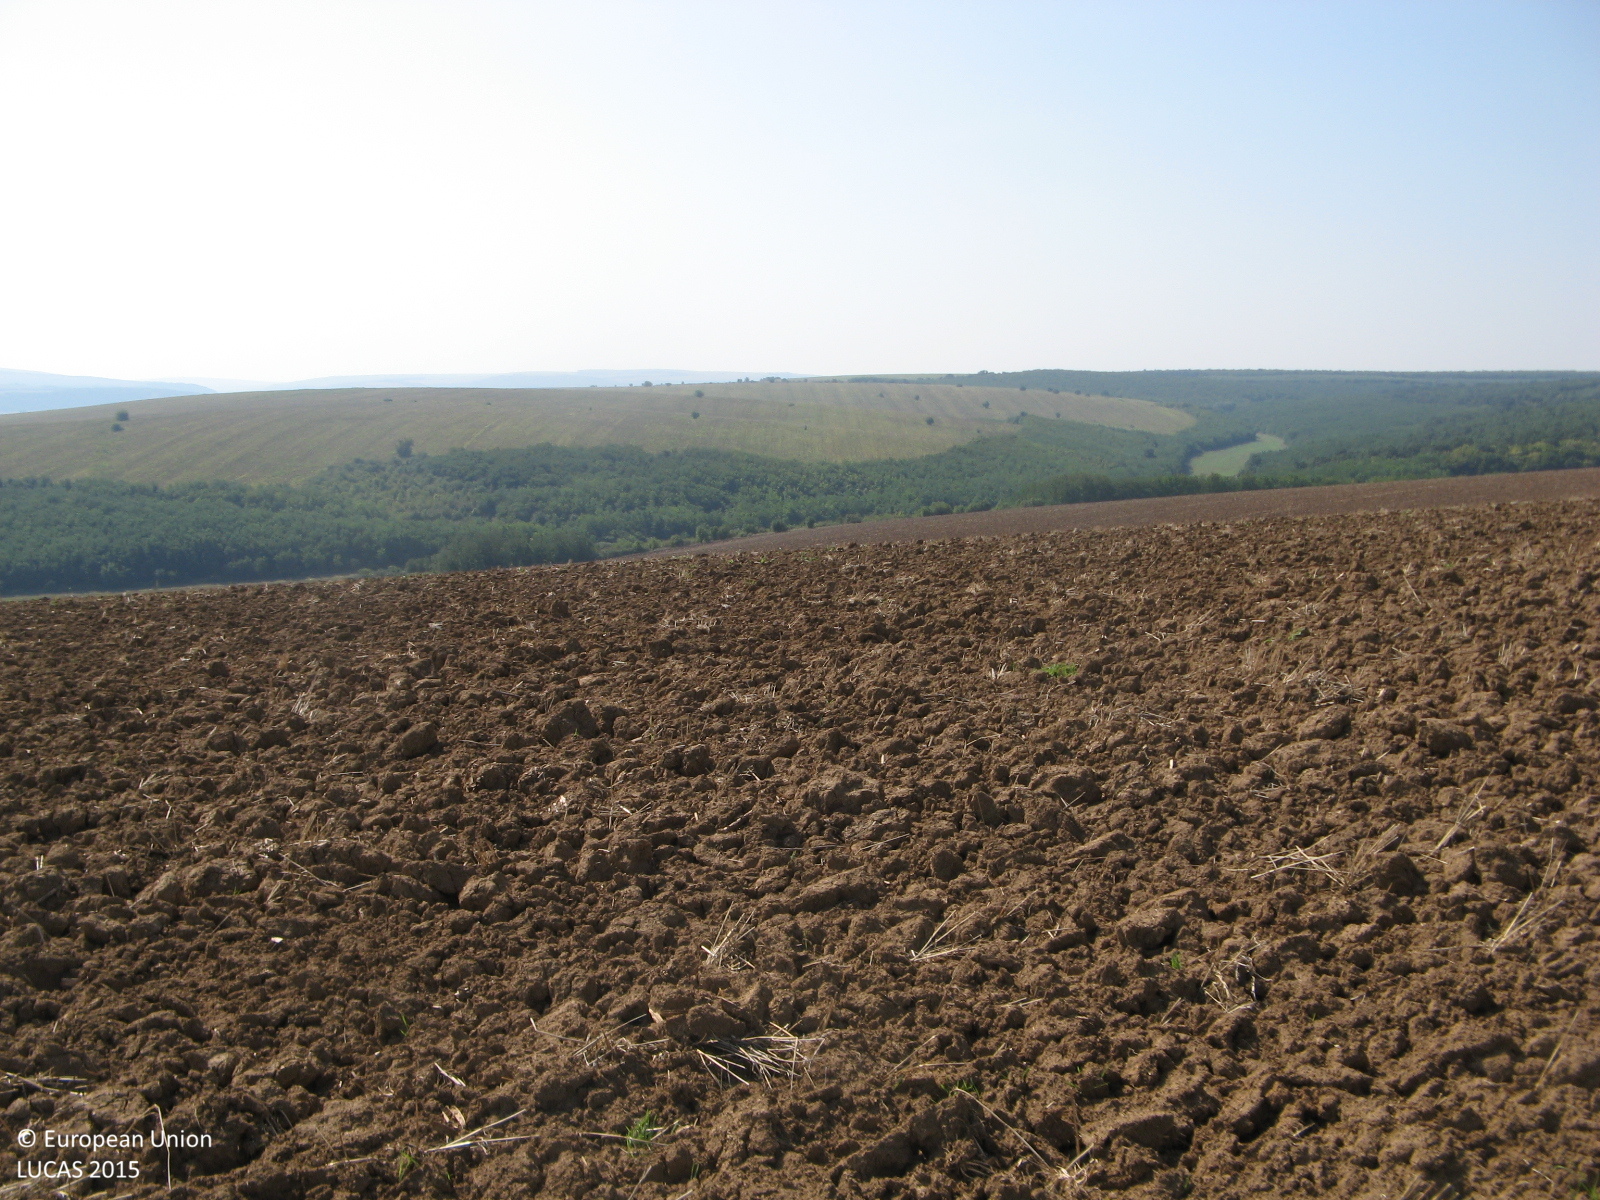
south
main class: Cropland
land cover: Common wheat
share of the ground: < 10 %
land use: Agriculture (excluding fallow land and kitchen gardens)
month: August
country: BG
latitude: 43.4680
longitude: 25.8744
